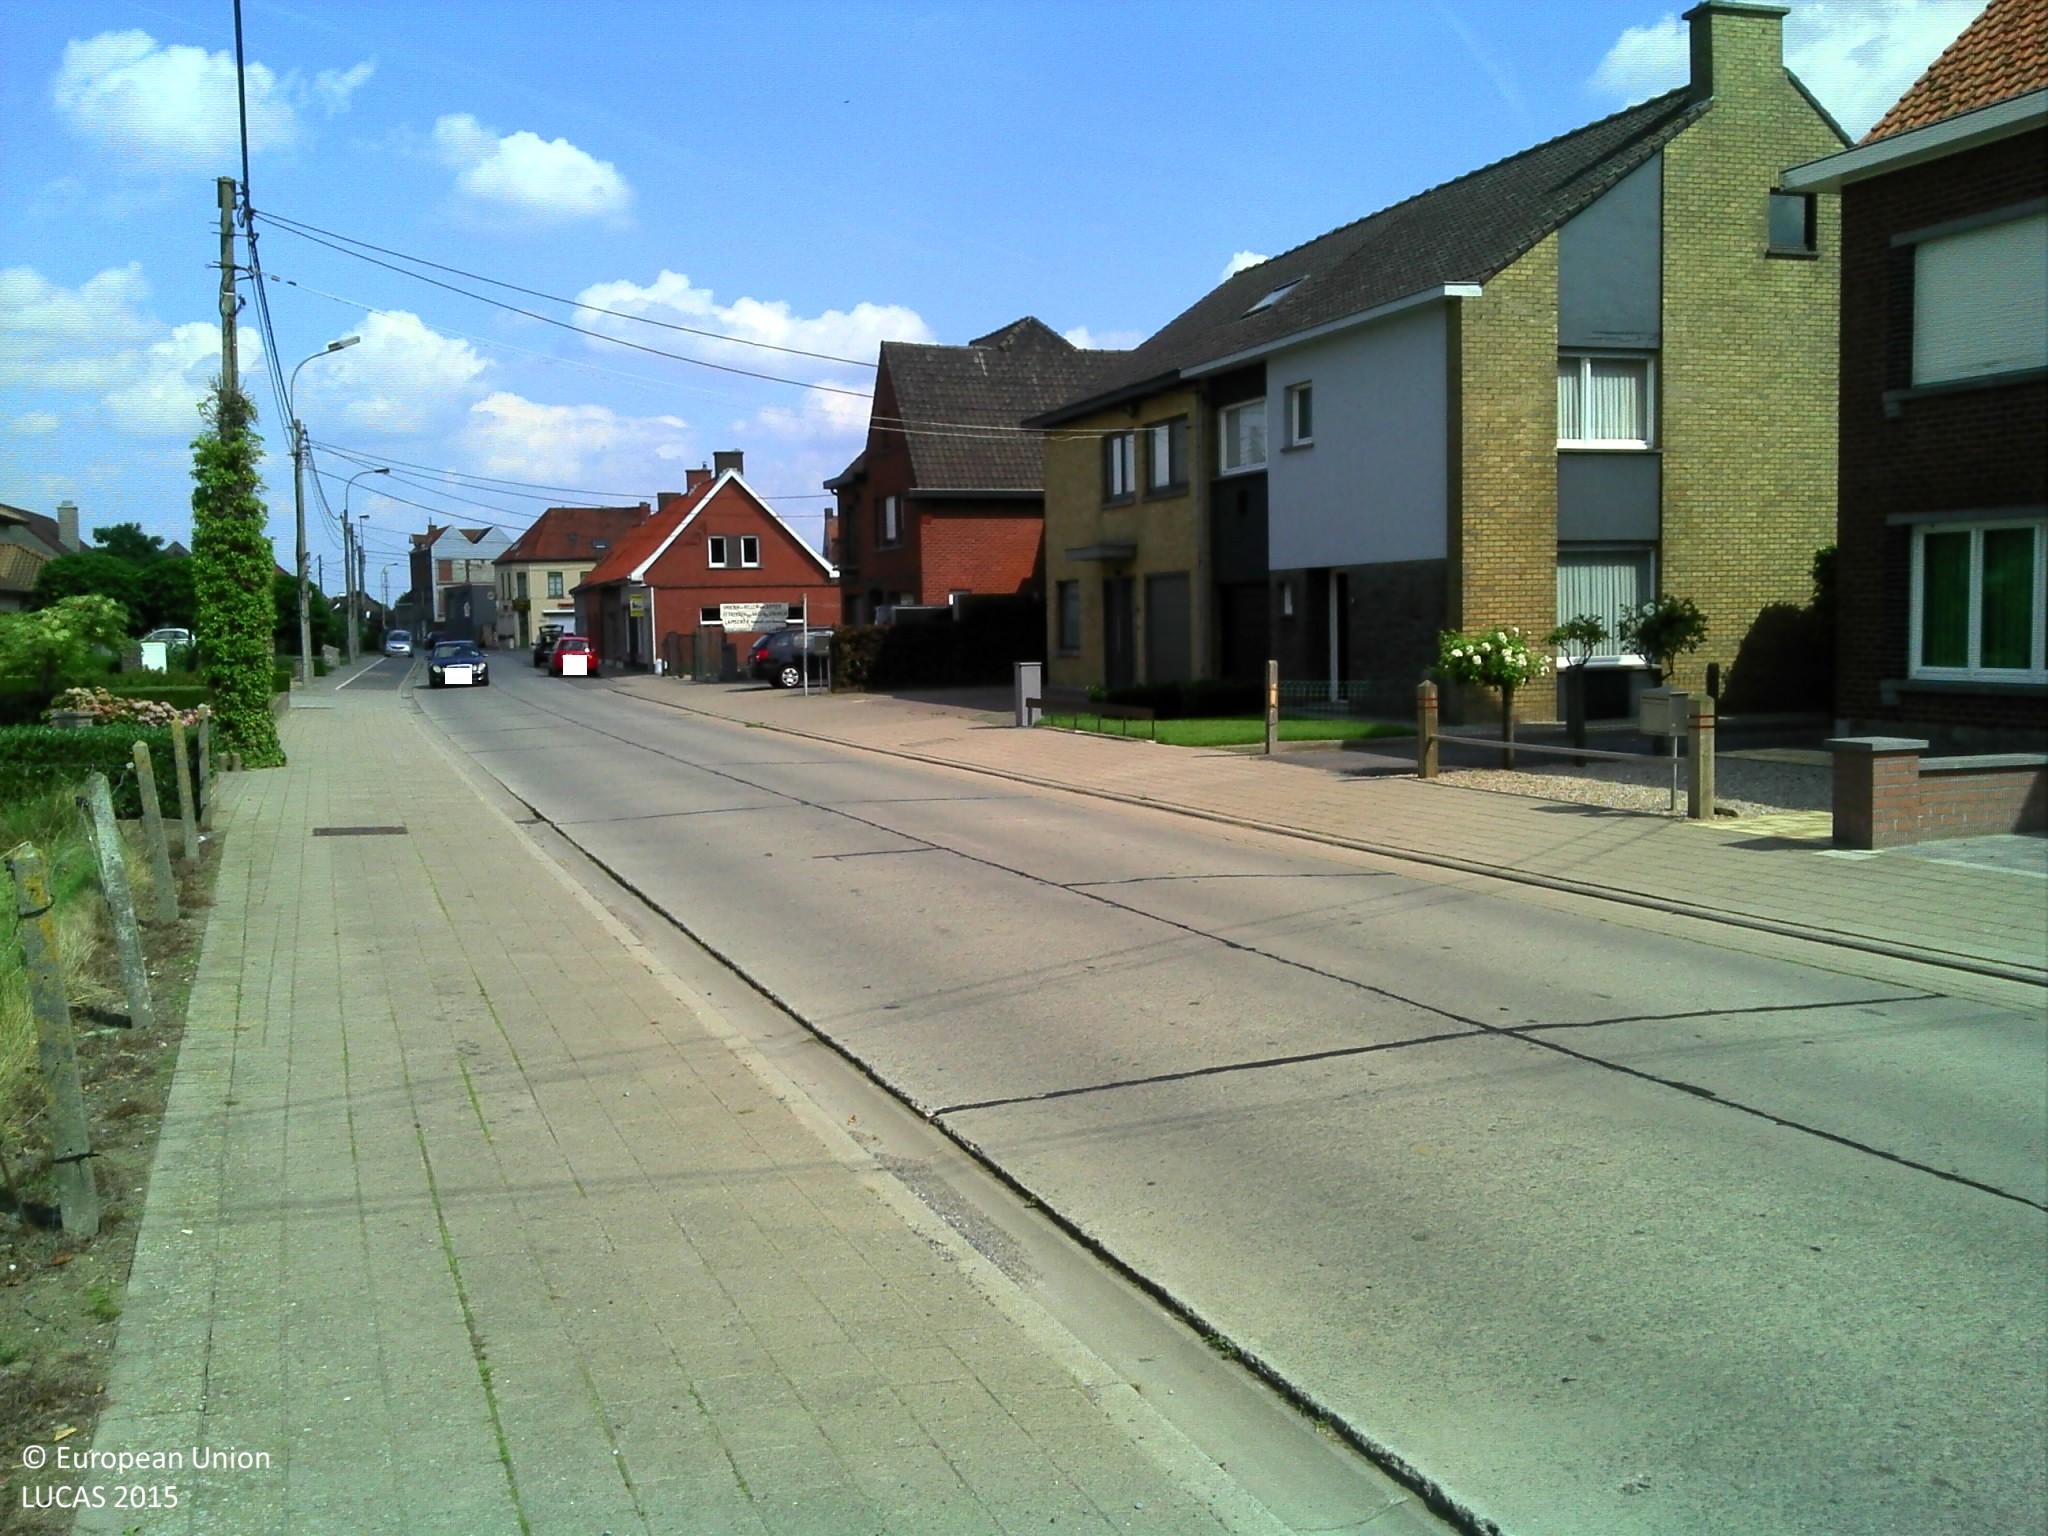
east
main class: Grassland
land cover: Grassland without tree/shrub cover
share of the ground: > 75 %
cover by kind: herbaceous plants 100 %
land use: Agriculture (excluding fallow land and kitchen gardens)
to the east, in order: Grassland without tree/shrub cover; Fences; Grassland without tree/shrub cover; Tracks; Grassland with sparse tree/shrub cover; Artificial constructions in urban areas
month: August
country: BE
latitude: 50.9310
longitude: 3.0895
